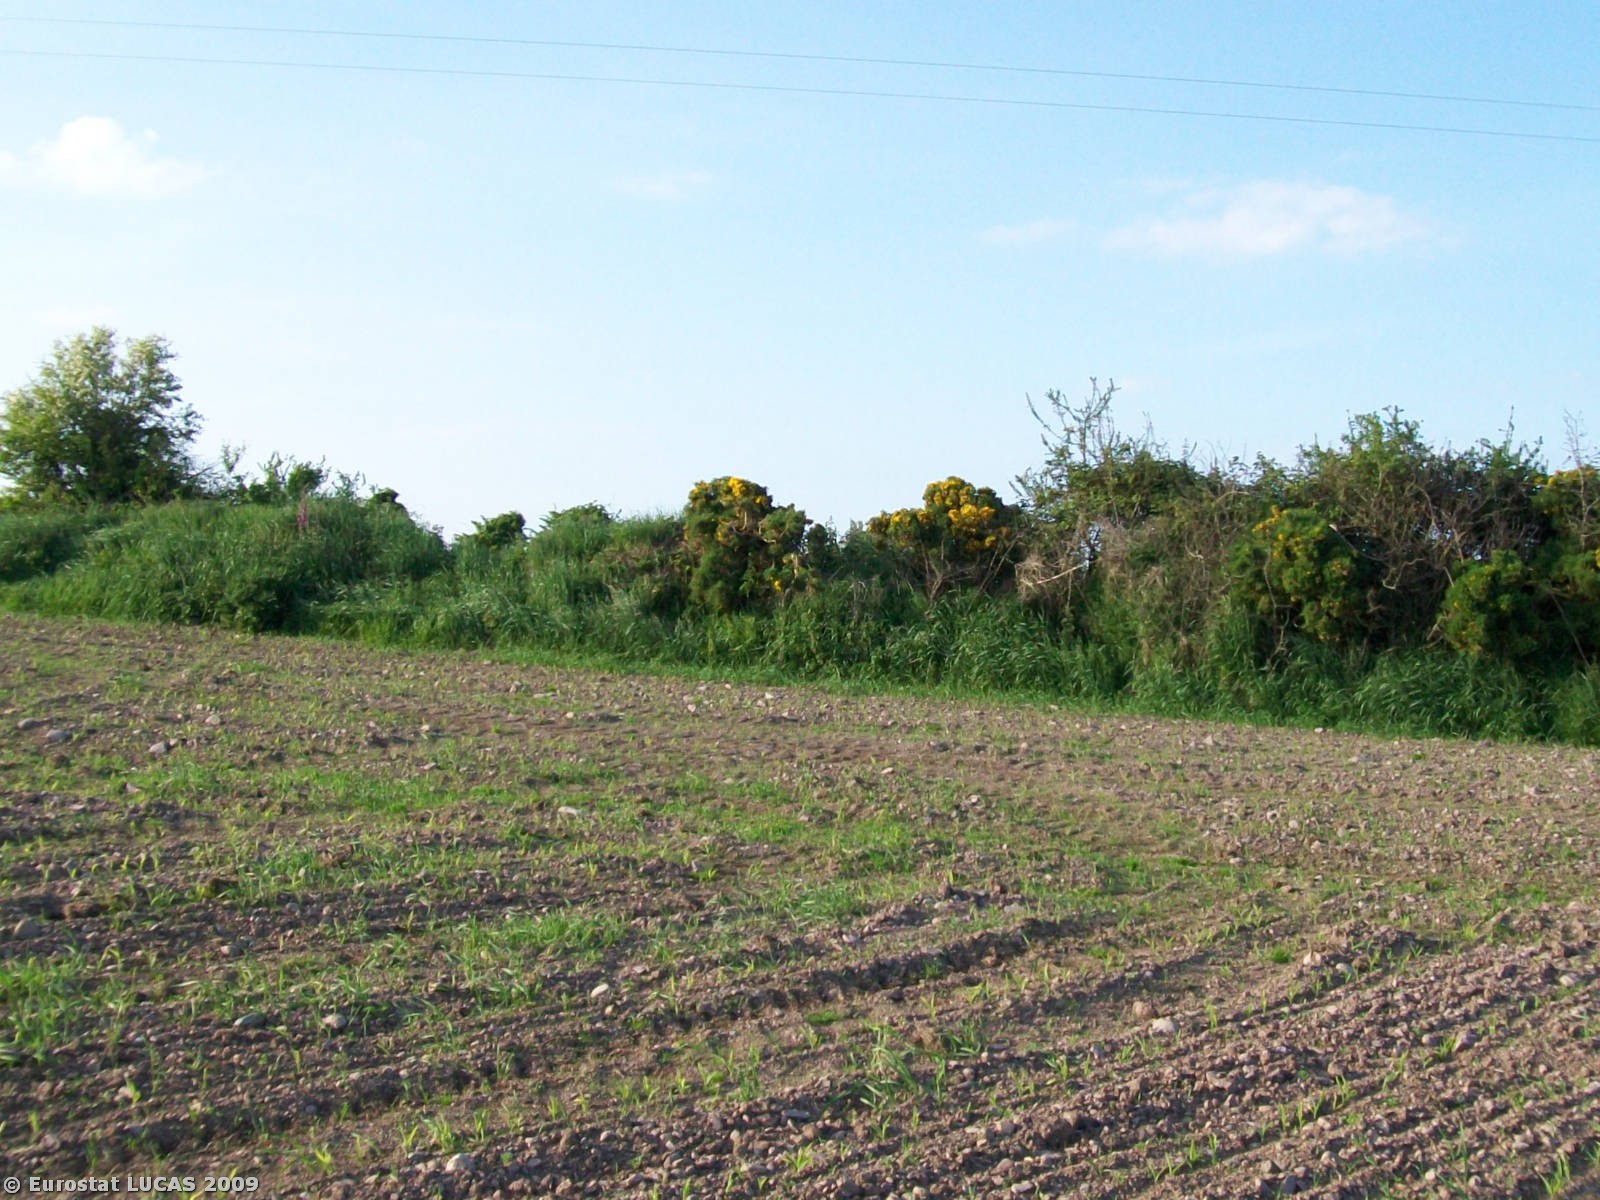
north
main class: Cropland
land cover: Common wheat
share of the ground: > 75 %
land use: Agriculture (excluding fallow land and kitchen gardens)
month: May
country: IE
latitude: 51.9012
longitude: -8.7333
